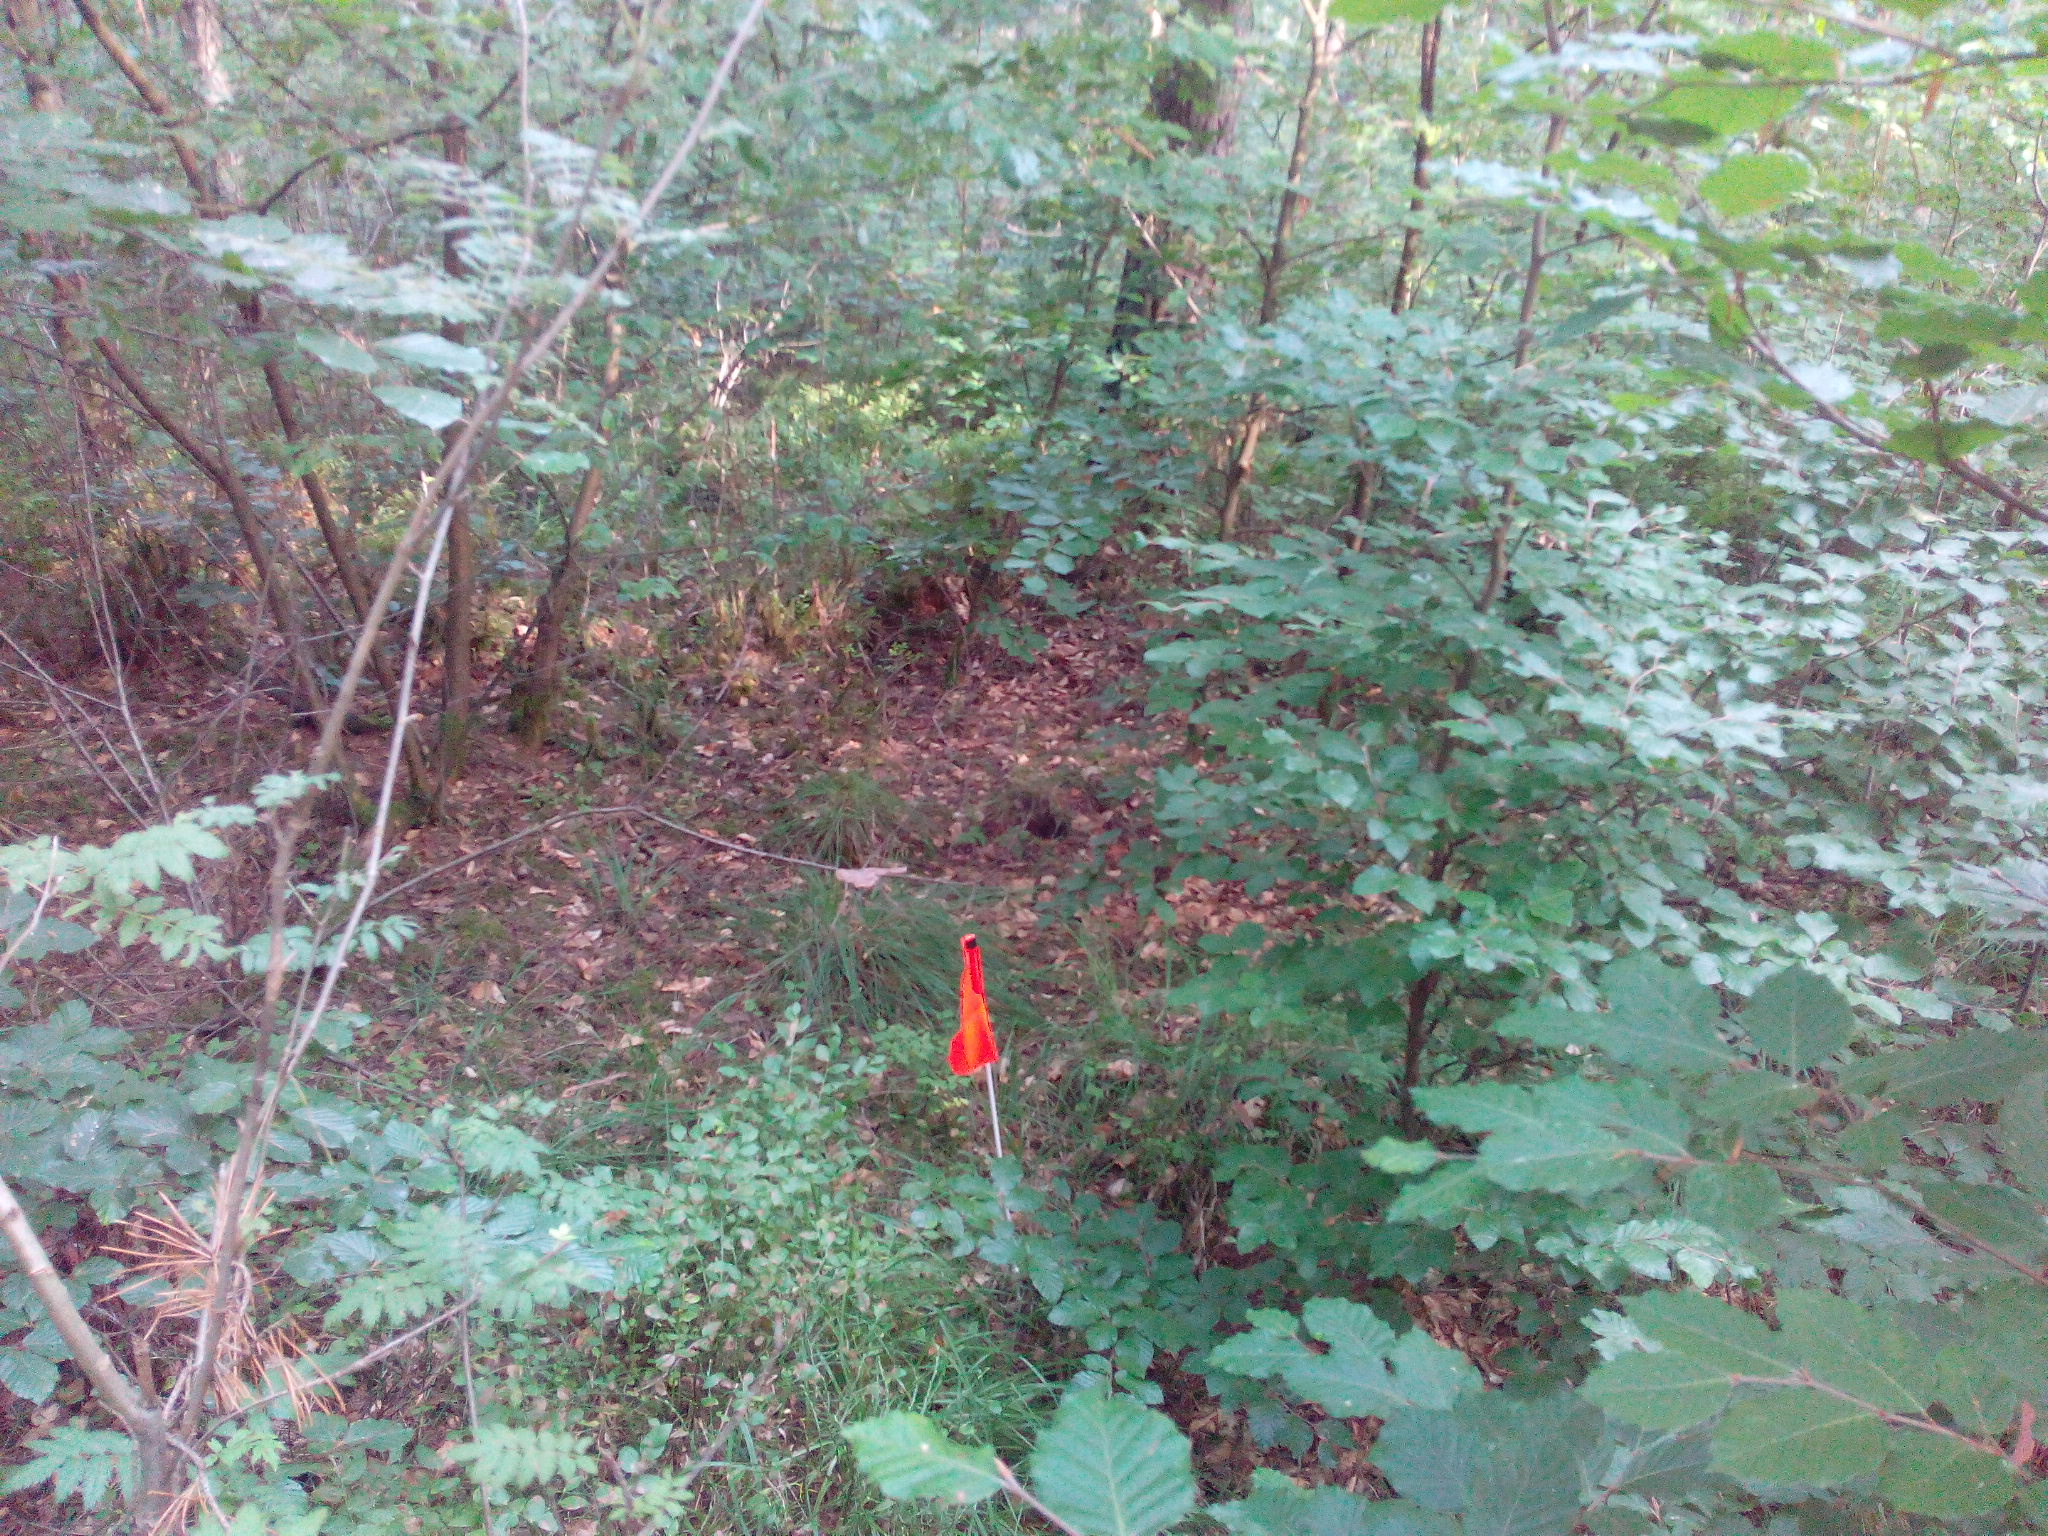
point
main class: Woodland
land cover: Pine dominated mixed woodland
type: hemiboreal forest and nemoral coniferous forest and mixed broadleaved-coniferous forest
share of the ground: > 75 %
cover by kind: coniferous forest trees 45 %, broadleaved forest trees 45 %, shrubs 5 %, herbaceous plants 5 %
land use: Forestry
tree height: > 5 m
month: August
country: DE
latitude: 52.5752
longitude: 9.9262
